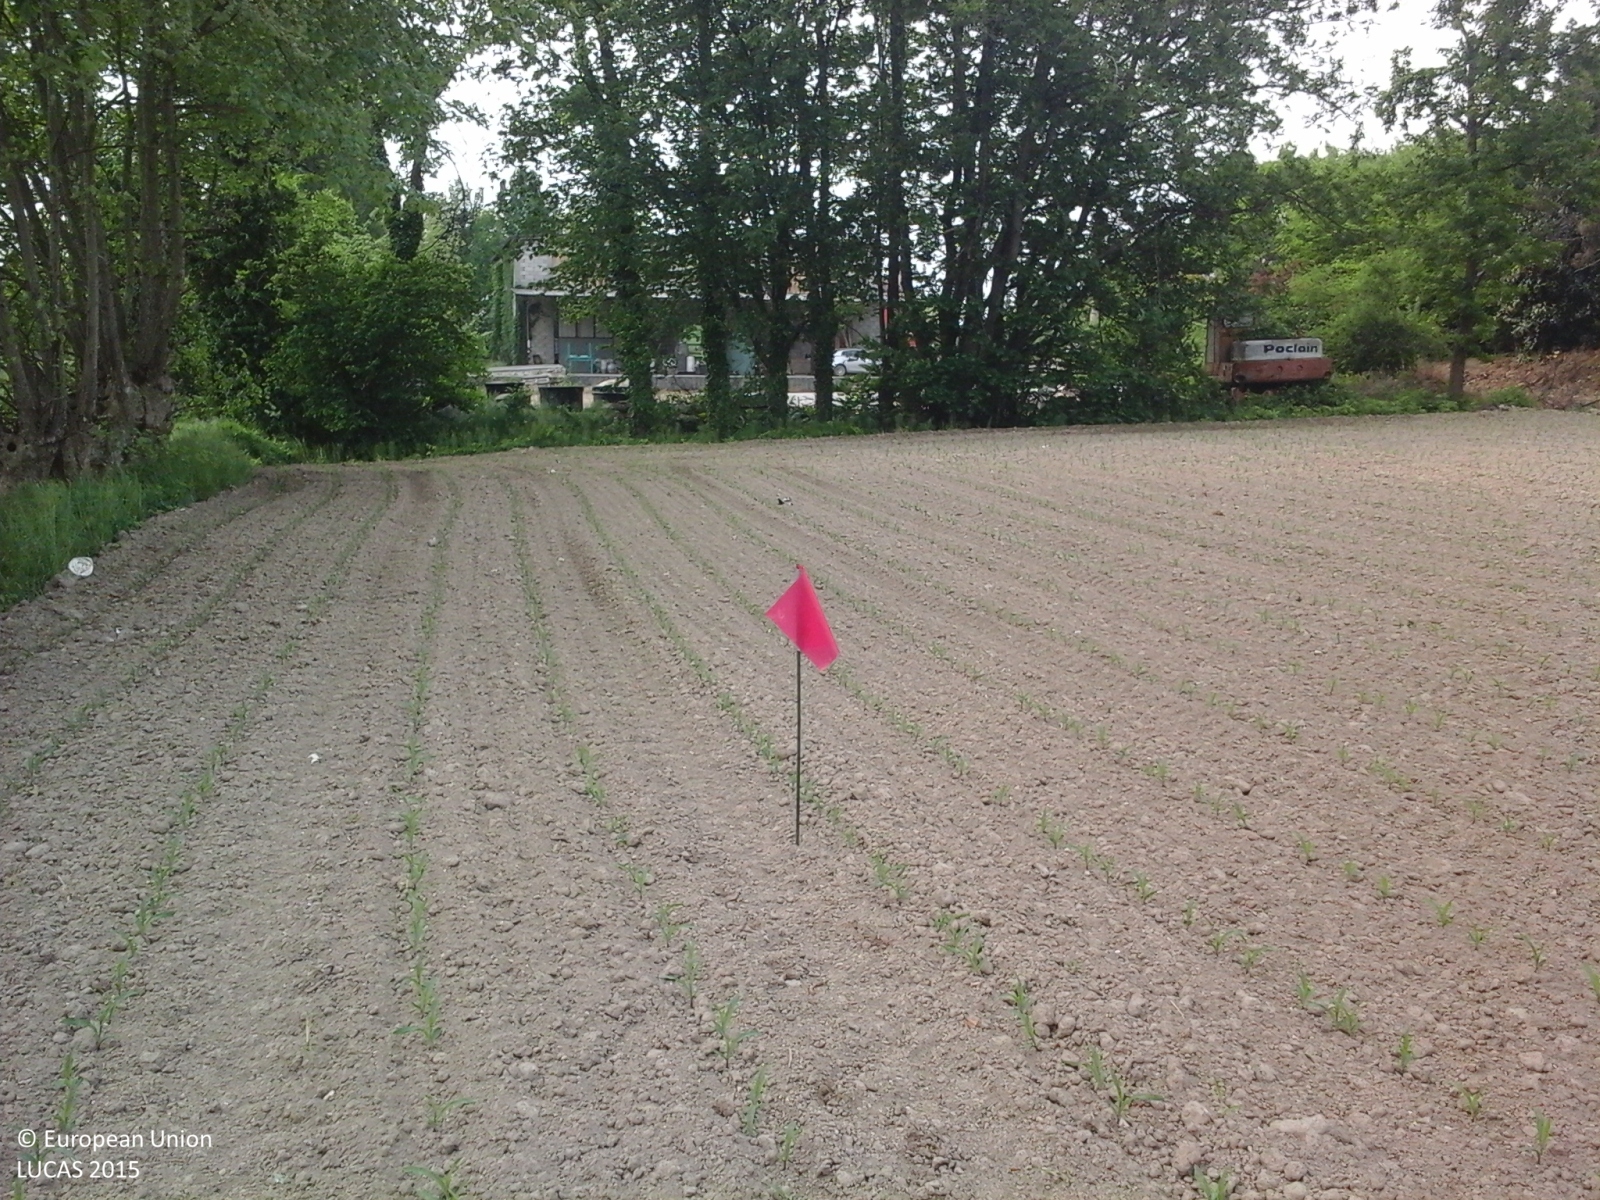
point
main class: Cropland
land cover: Maize
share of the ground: < 10 %
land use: Agriculture (excluding fallow land and kitchen gardens)
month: May
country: IT
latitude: 45.1612
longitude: 10.3936
